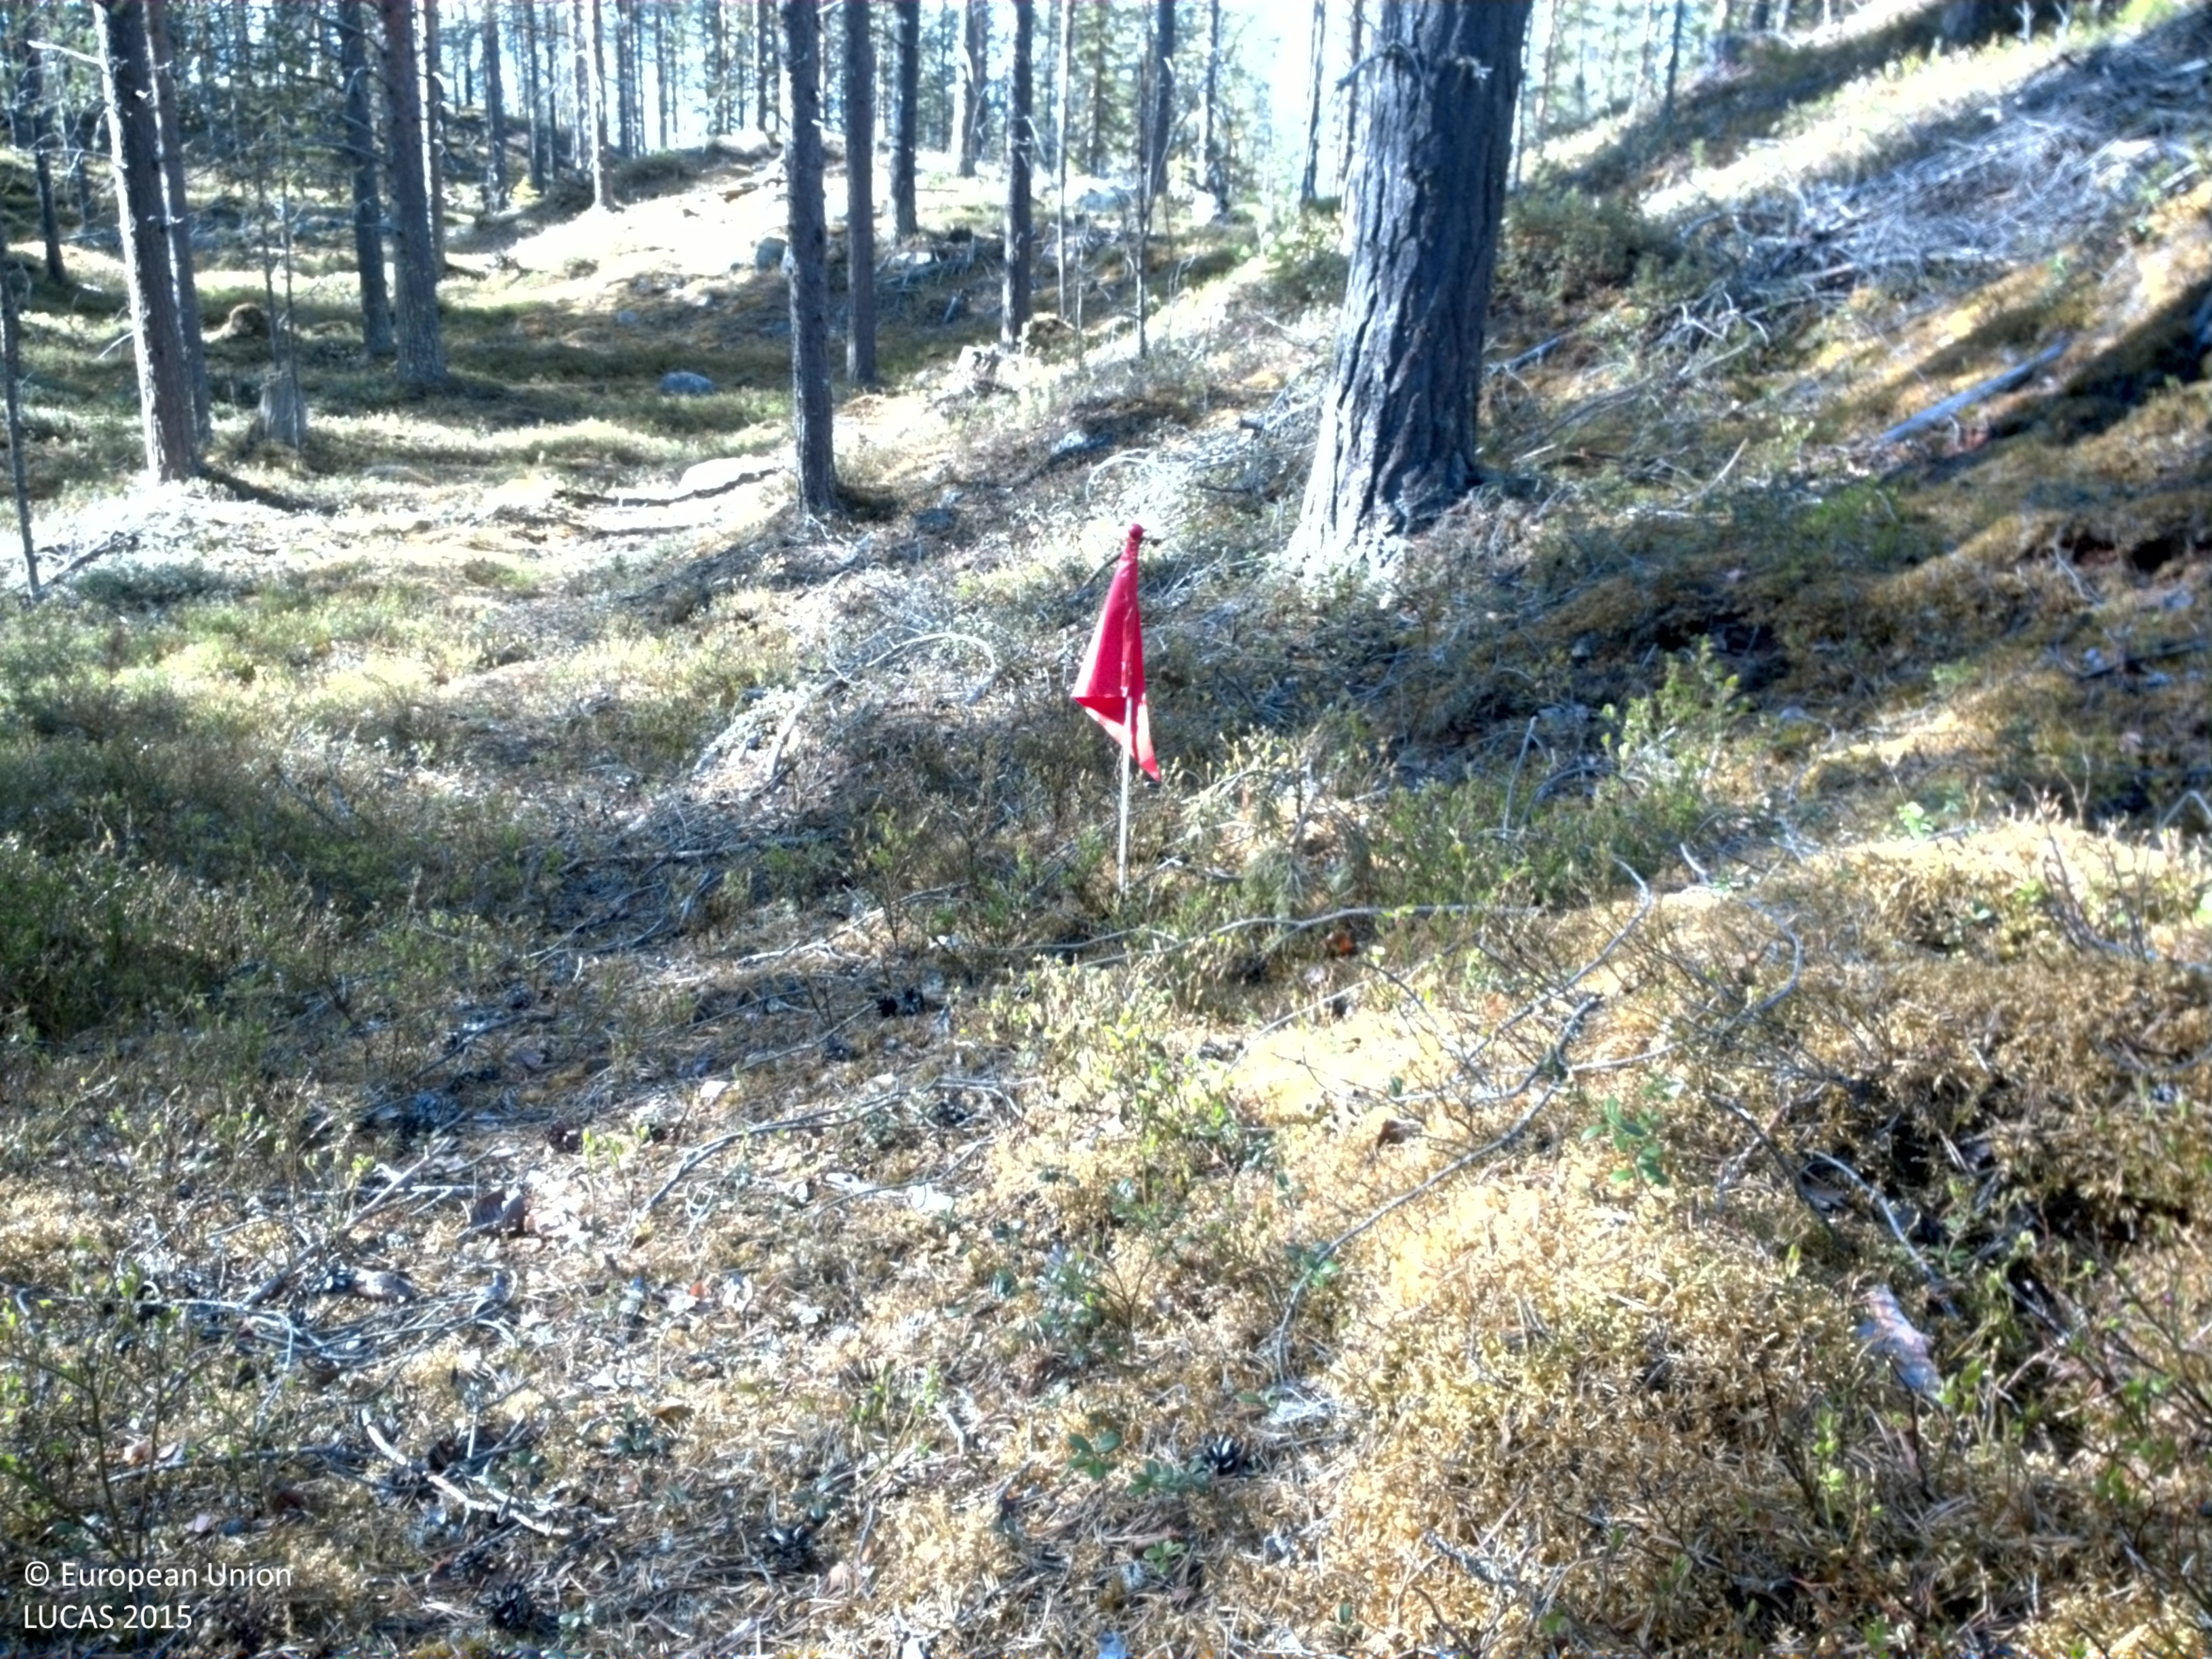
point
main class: Woodland
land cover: Pine dominated coniferous woodland
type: boreal forest
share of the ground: 25 - 50 %
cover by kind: herbaceous plants 65 %, coniferous forest trees 35 %
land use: Forestry
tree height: > 5 m
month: June
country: SE
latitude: 66.9420
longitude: 21.2811
